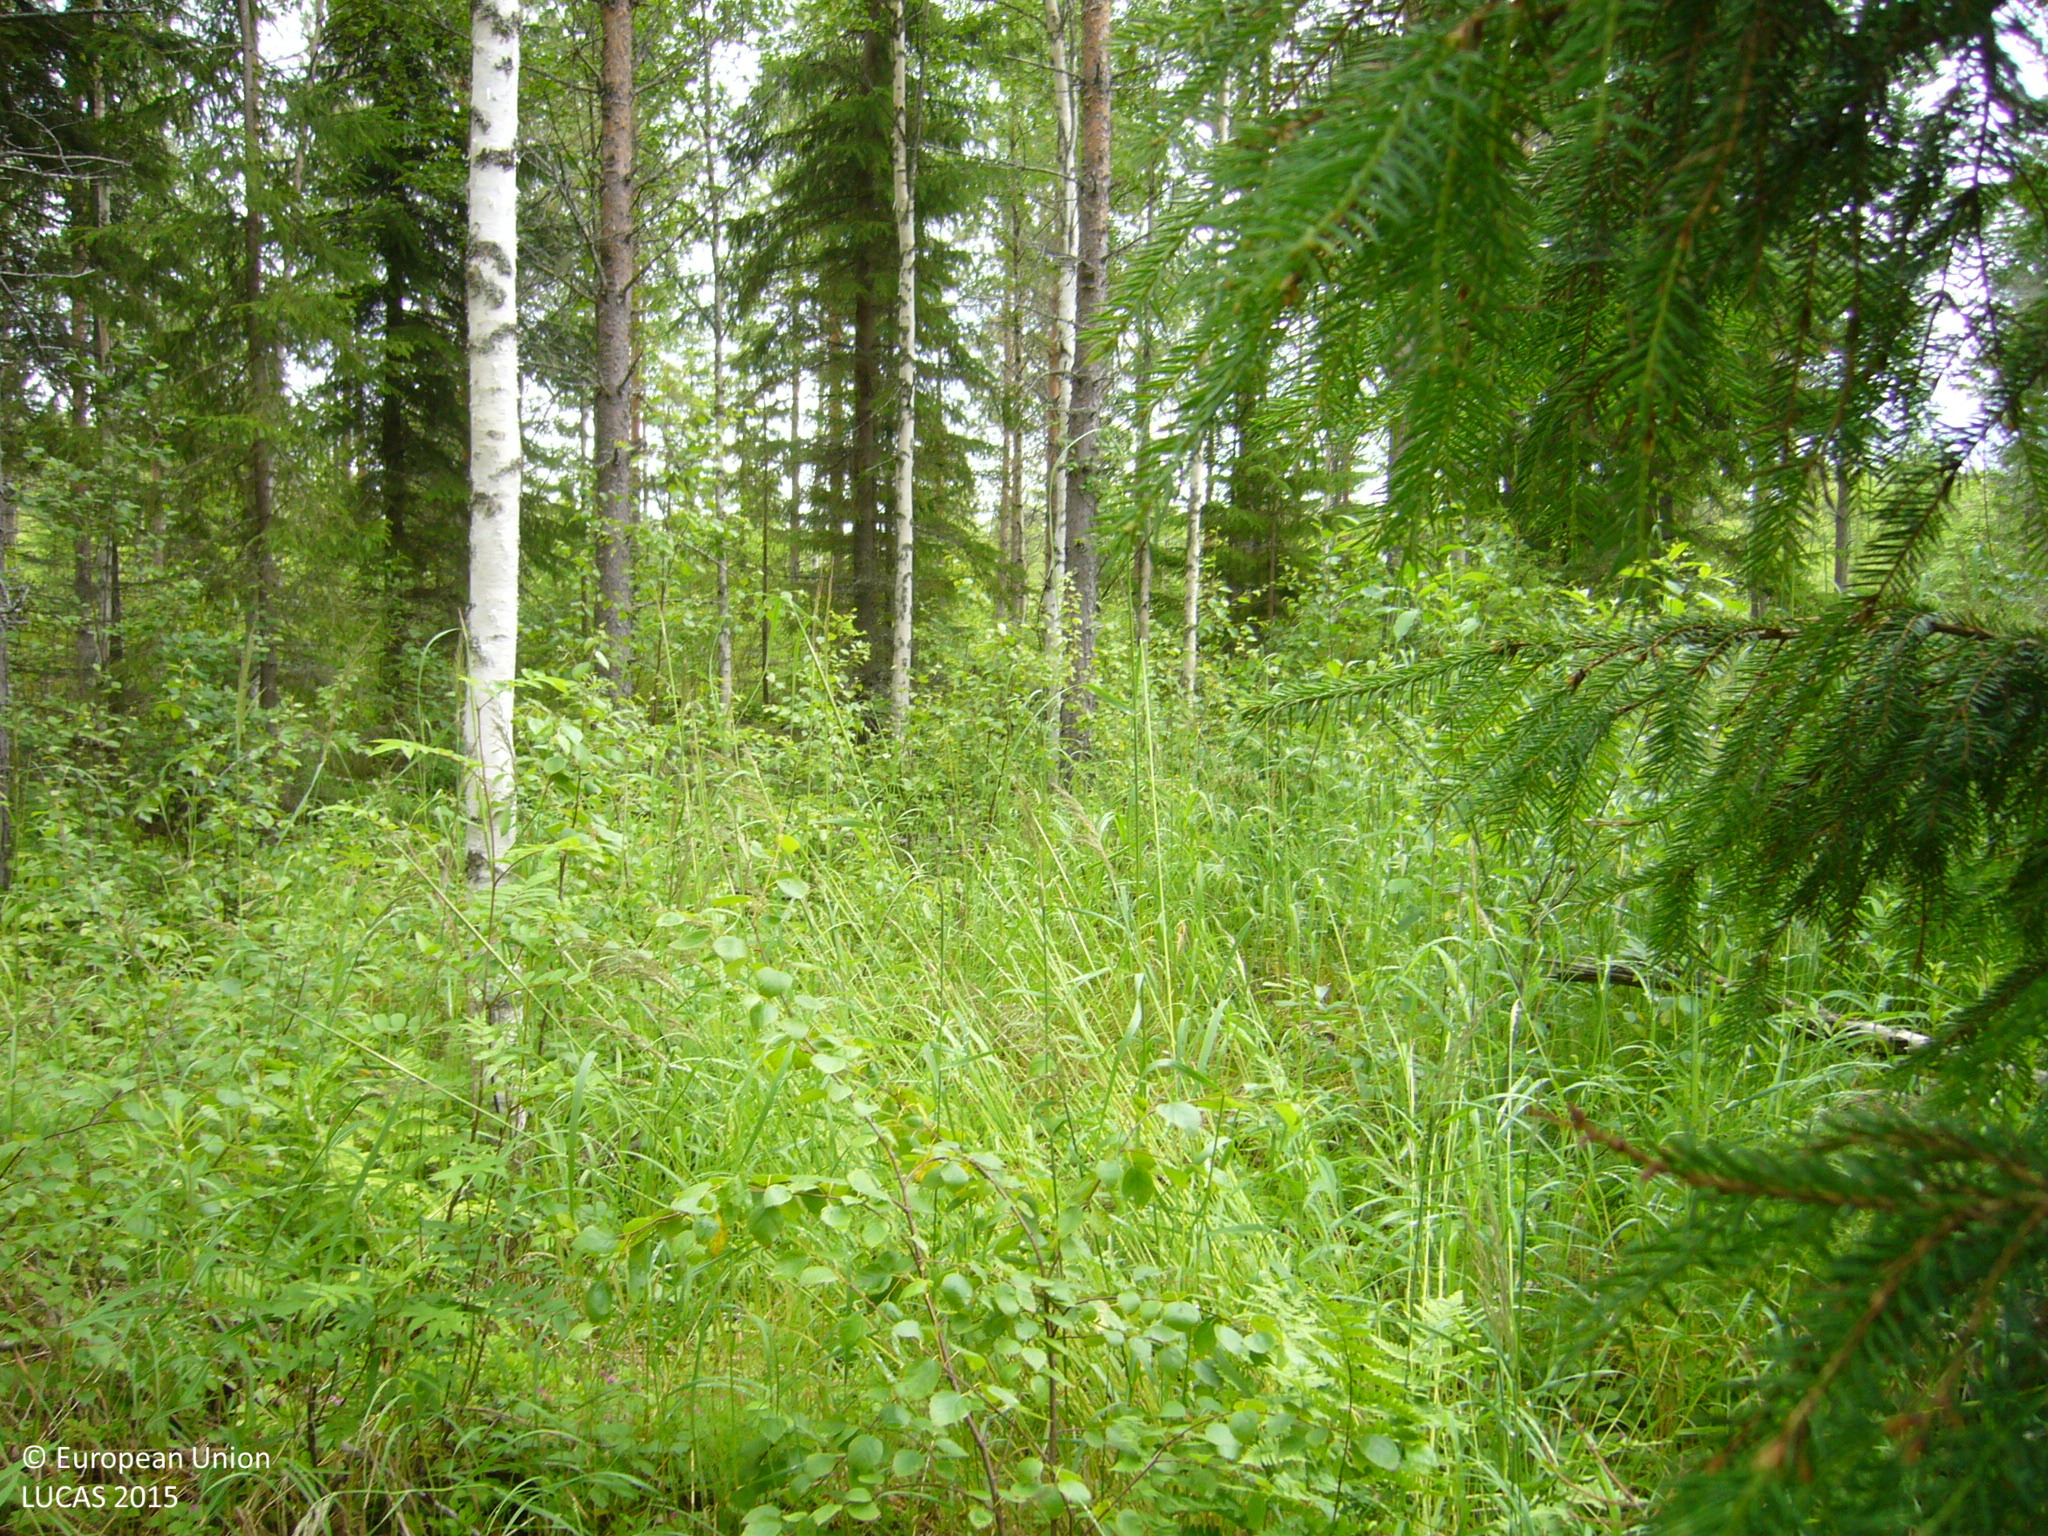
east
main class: Woodland
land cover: Pine dominated mixed woodland
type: boreal forest
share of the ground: > 75 %
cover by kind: coniferous forest trees 50 %, broadleaved forest trees 25 %, shrubs 25 %
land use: Forestry
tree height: > 5 m
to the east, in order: Pine dominated mixed woodland; Ditches and canals; Pine dominated mixed woodland; Ditches and canals; Pine dominated mixed woodland; Ditches and canals; Pine dominated mixed woodland; Spruce dominated mixed woodland; Ditches and canals; Spruce dominated mixed woodland; Ditches and canals; Spruce dominated mixed woodland; Ditches and canals; Spruce dominated mixed woodland; Ditches and canals; Spruce dominated mixed woodland; Ditches and canals; Spruce dominated mixed woodland
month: July
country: FI
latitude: 63.4101
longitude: 25.2966
